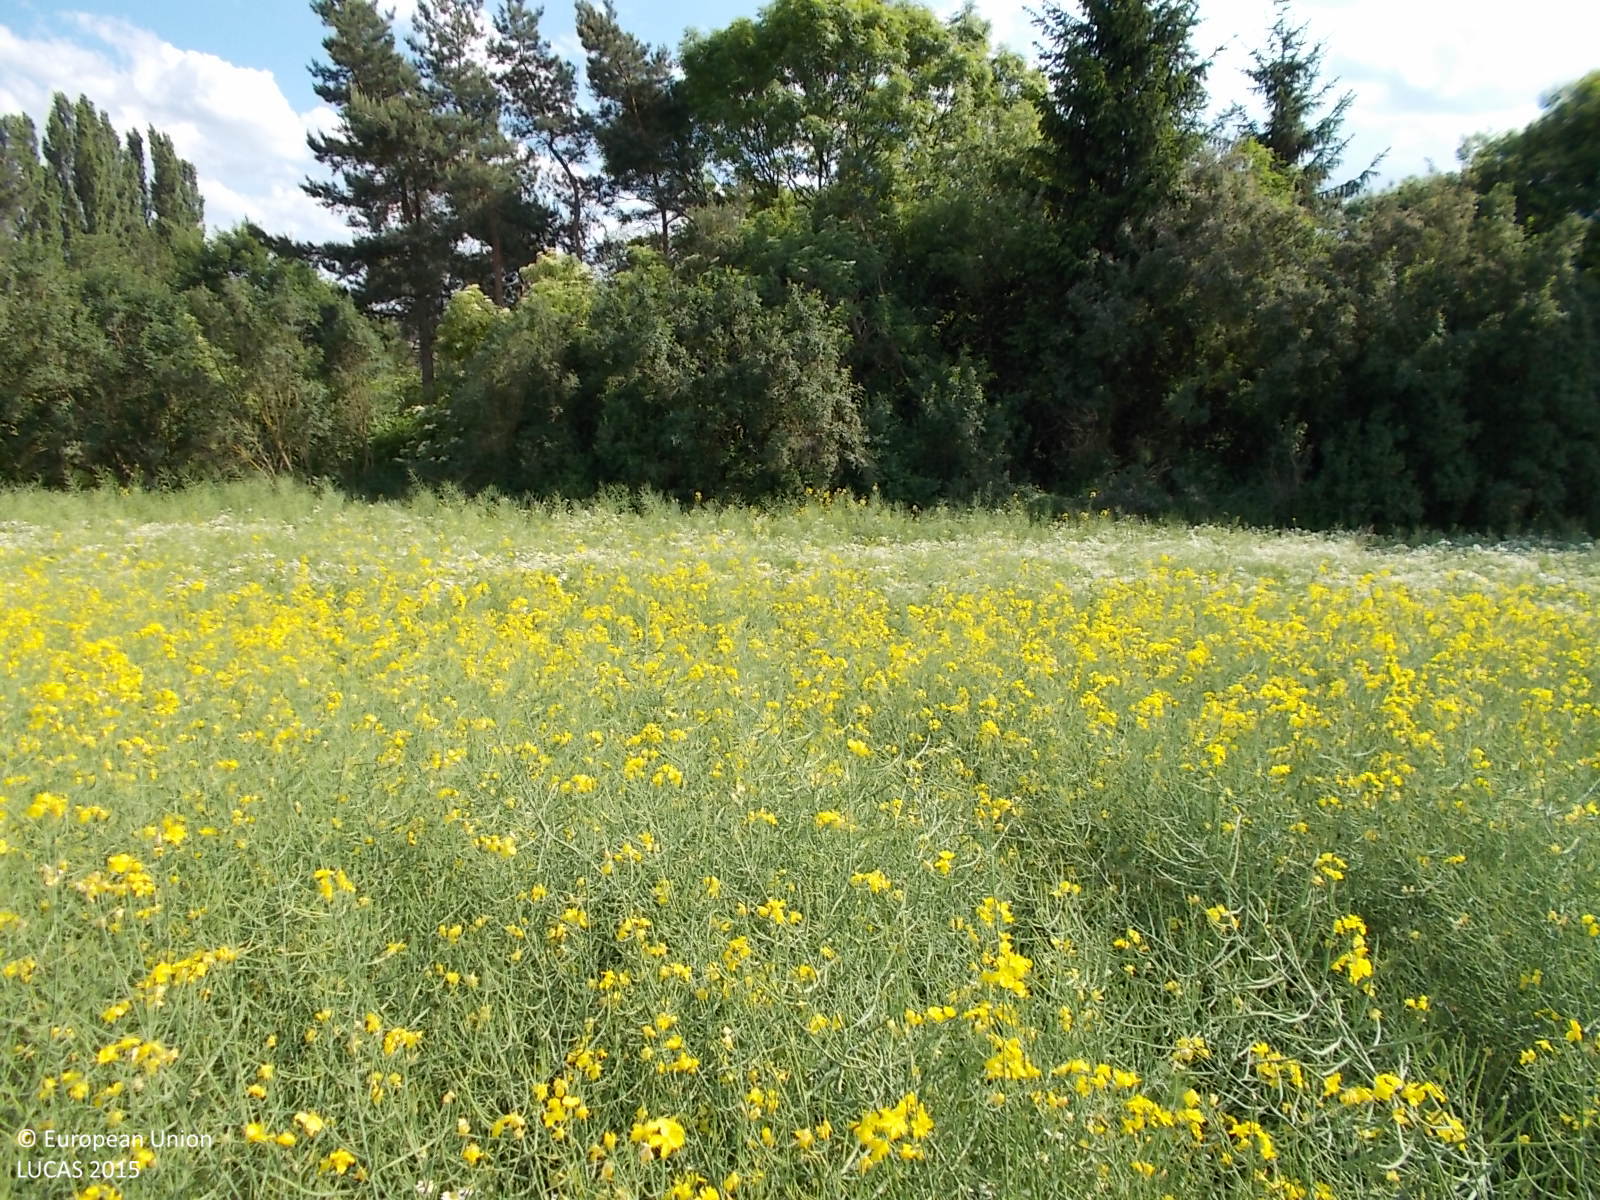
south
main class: Cropland
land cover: Rape and turnip rape
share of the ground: > 75 %
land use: Agriculture (excluding fallow land and kitchen gardens)
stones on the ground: < 10 %
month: June
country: CZ
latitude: 49.9420
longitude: 15.1448
